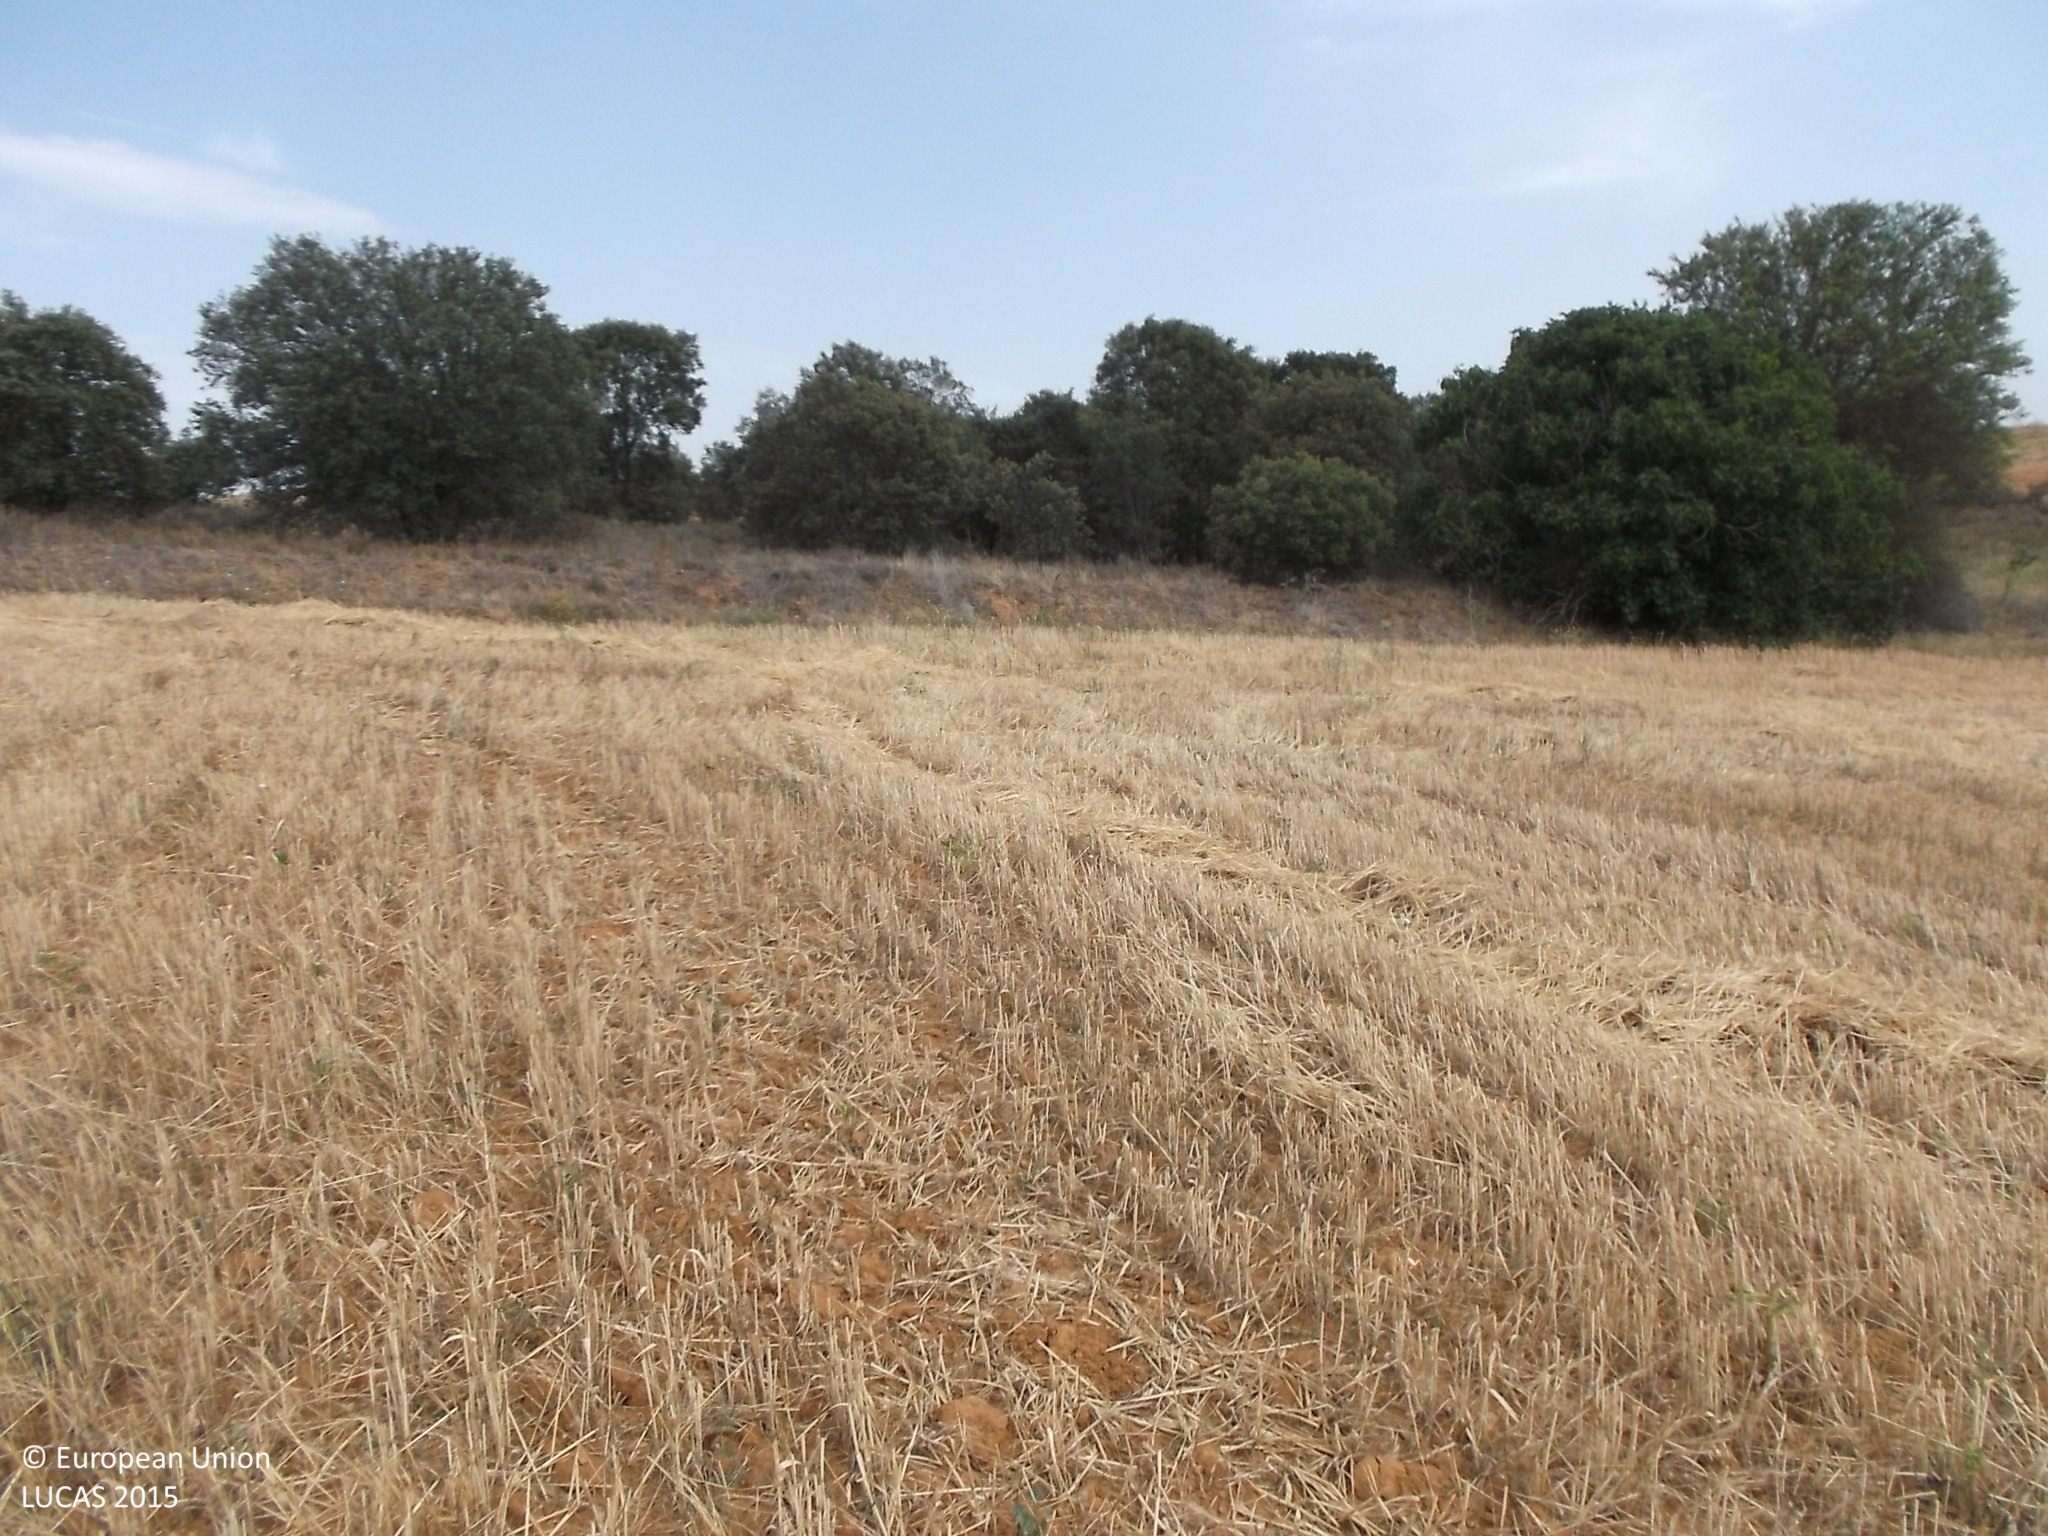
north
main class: Cropland
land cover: Common wheat
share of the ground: < 10 %
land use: Agriculture (excluding fallow land and kitchen gardens)
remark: Harvested field
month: July
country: ES
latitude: 41.5742
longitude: -5.5425
